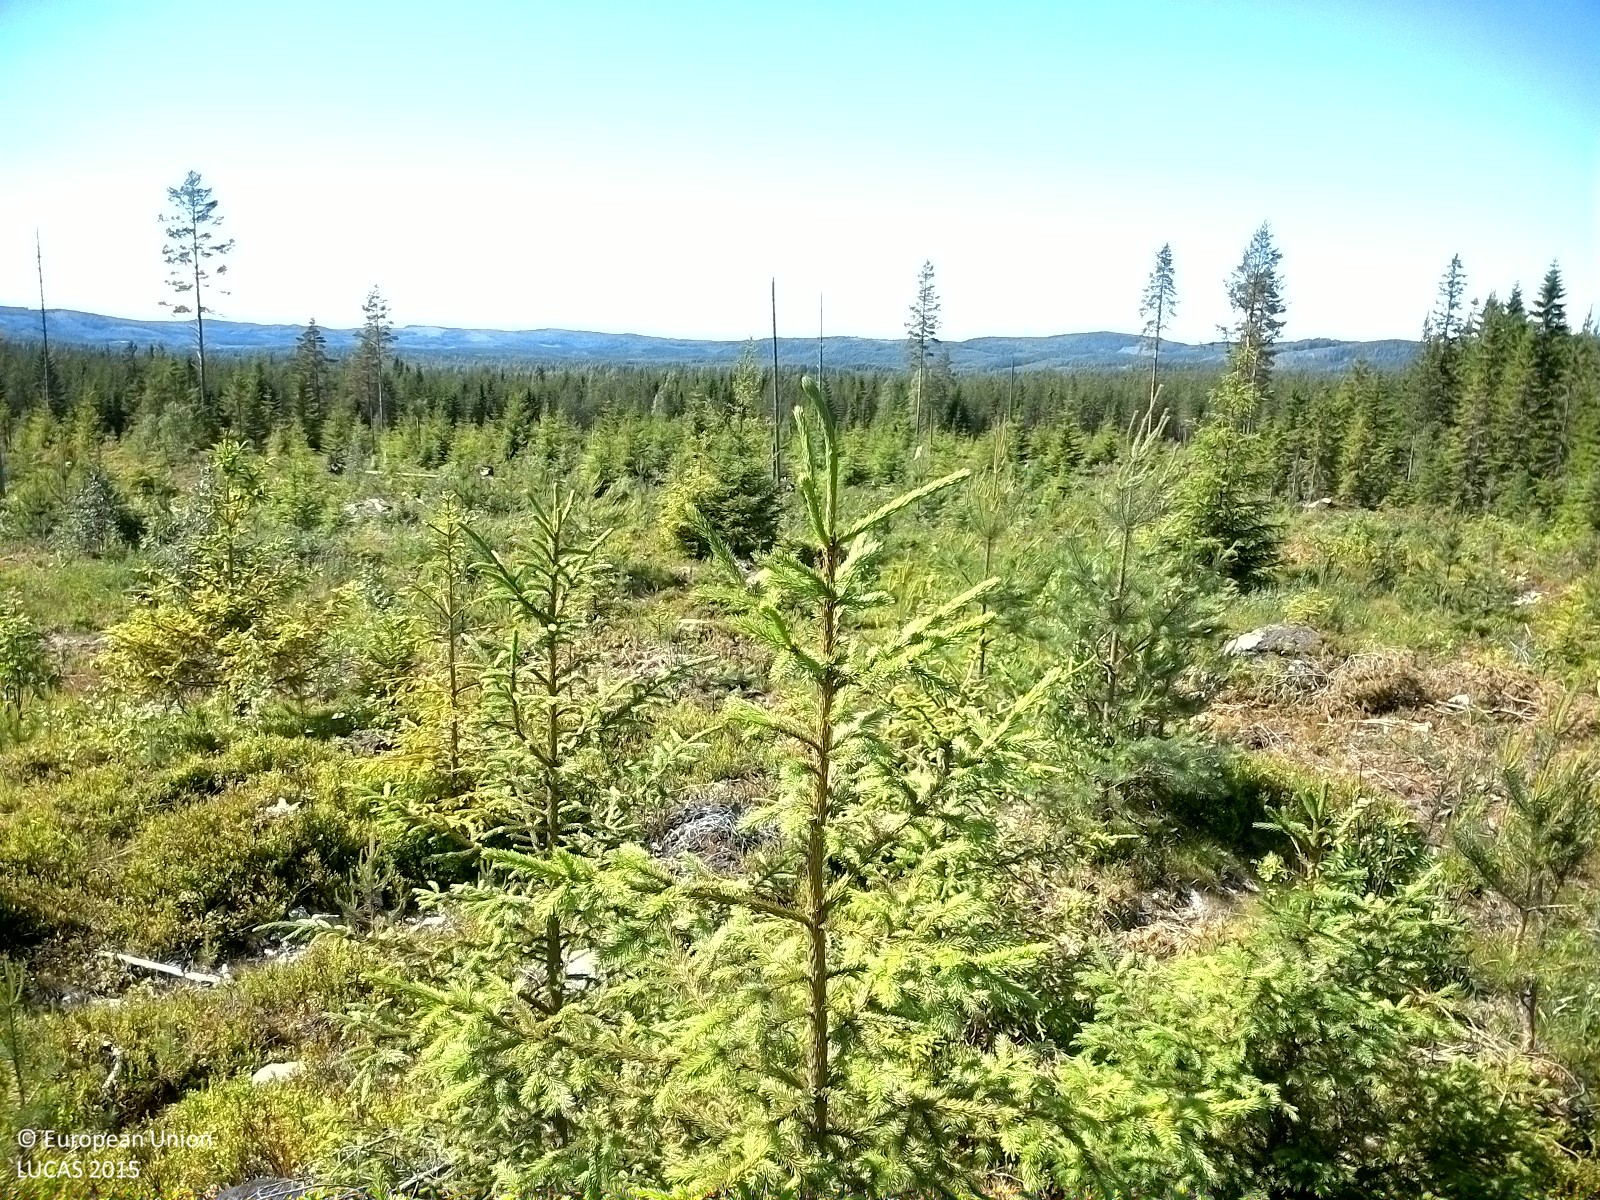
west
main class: Woodland
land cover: Spruce dominated coniferous woodland
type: boreal forest
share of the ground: 10 - 25 %
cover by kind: shrubs 70 %, coniferous forest trees 10 %, herbaceous plants 10 %, unconsolidated bare surface 10 %
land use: Forestry
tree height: < 5 m
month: July
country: SE
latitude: 62.2374
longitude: 16.8893
